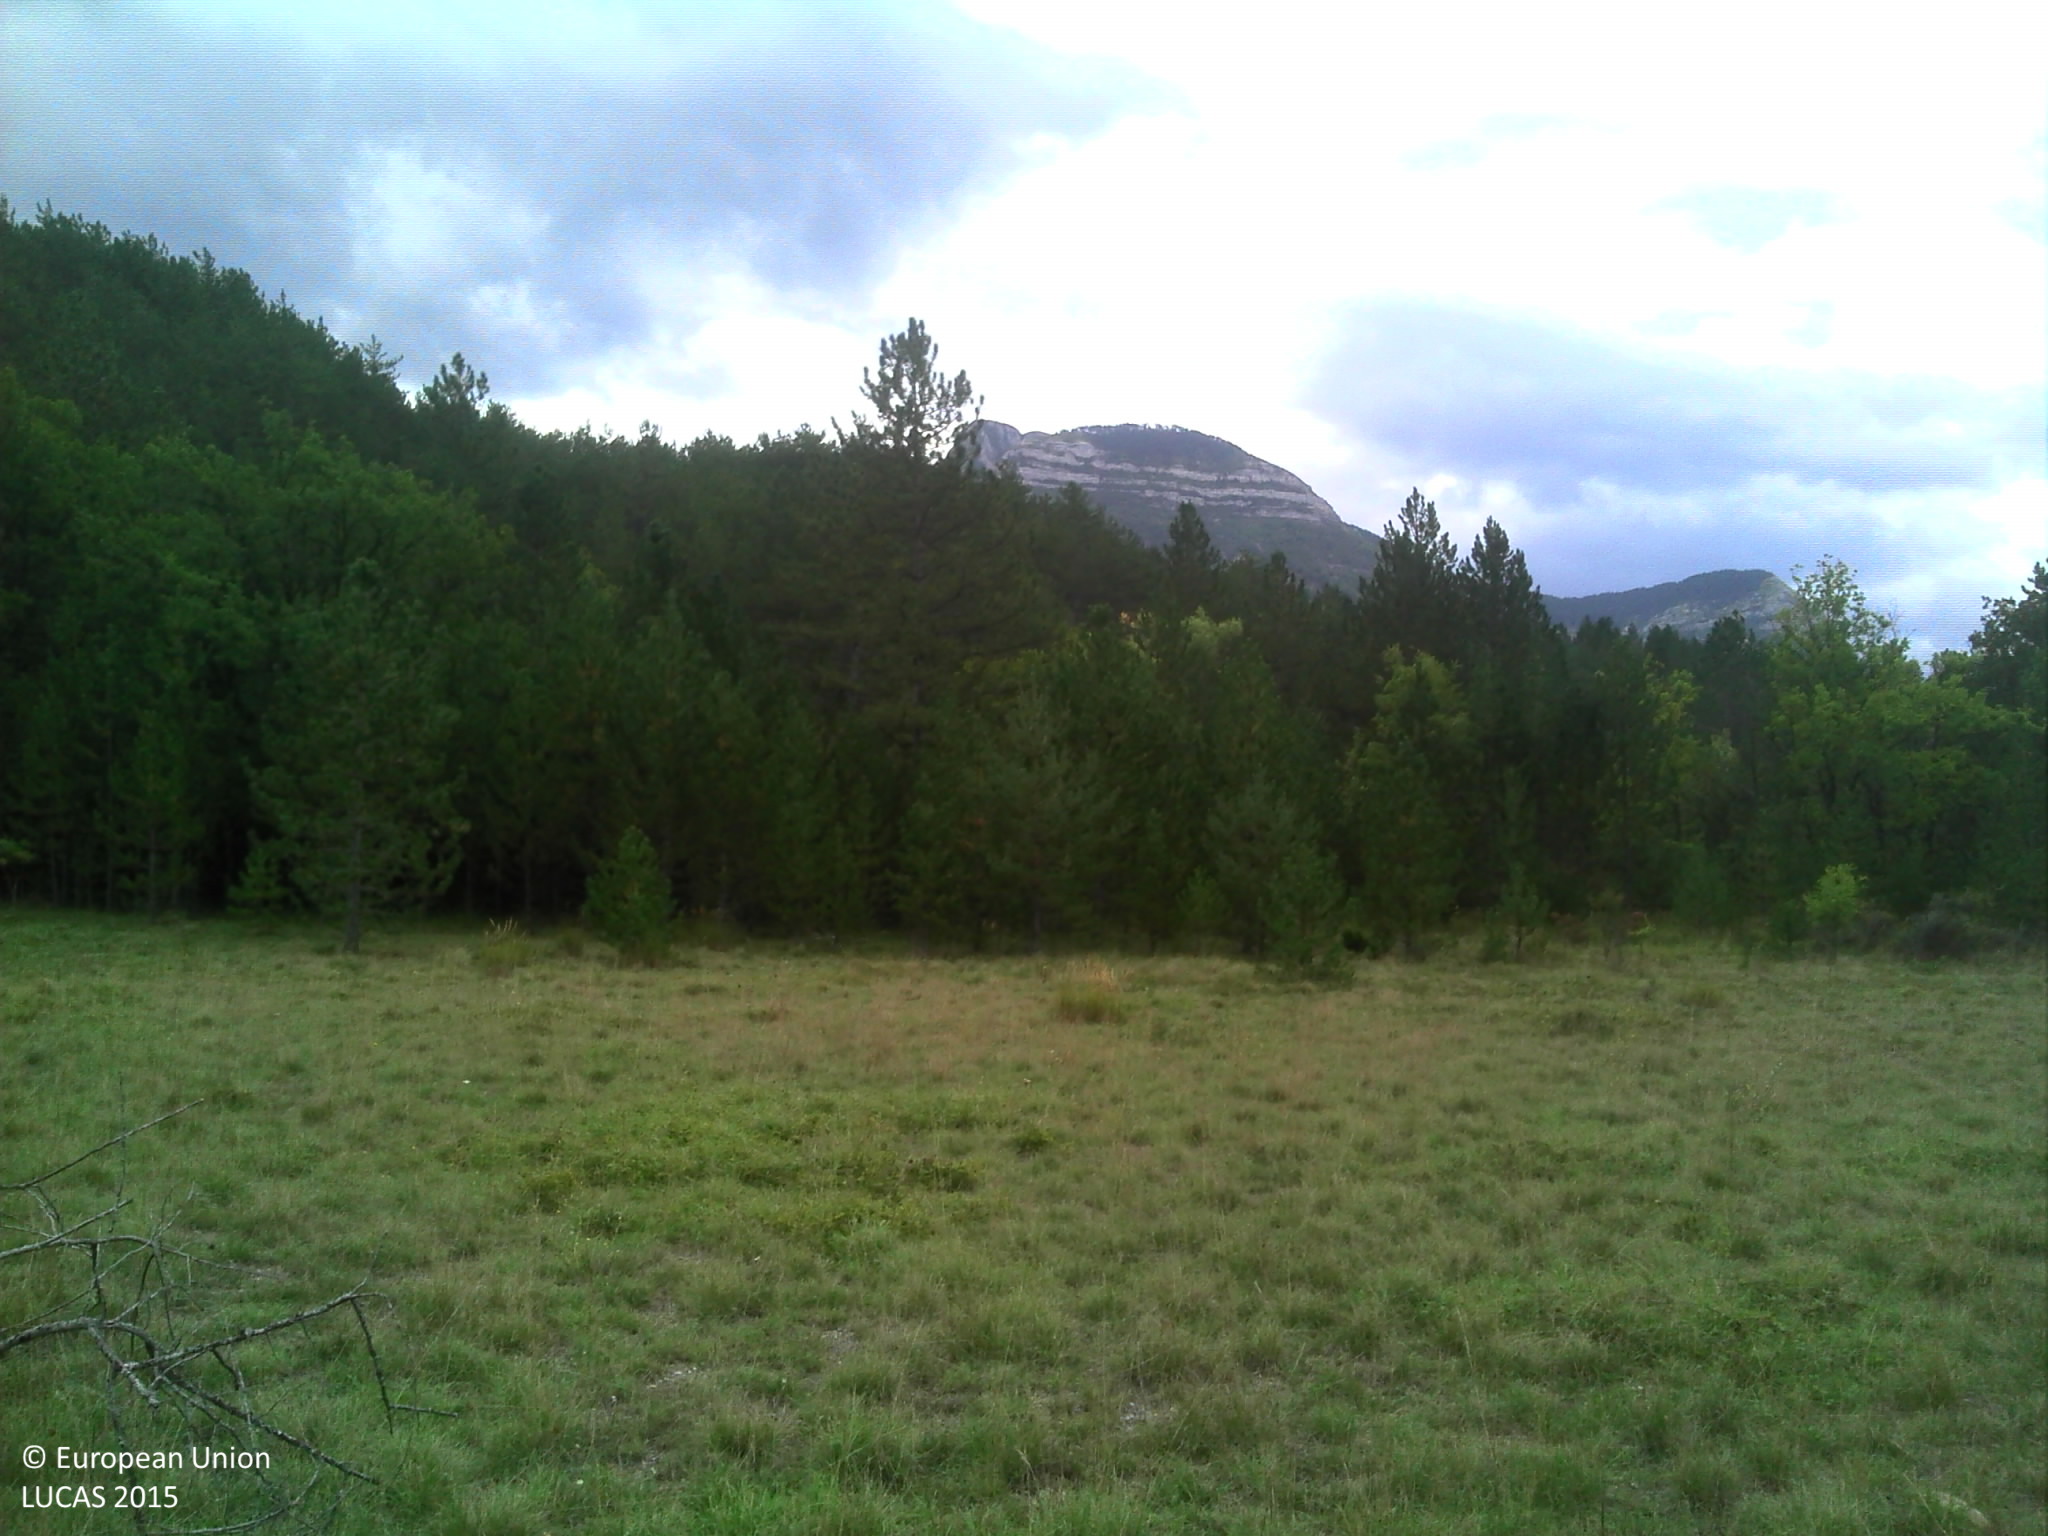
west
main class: Grassland
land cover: Grassland without tree/shrub cover
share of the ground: > 75 %
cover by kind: herbaceous plants 95 %, shrubs 5 %
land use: Agriculture (excluding fallow land and kitchen gardens)
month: September
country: FR
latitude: 44.4460
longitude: 5.3705
